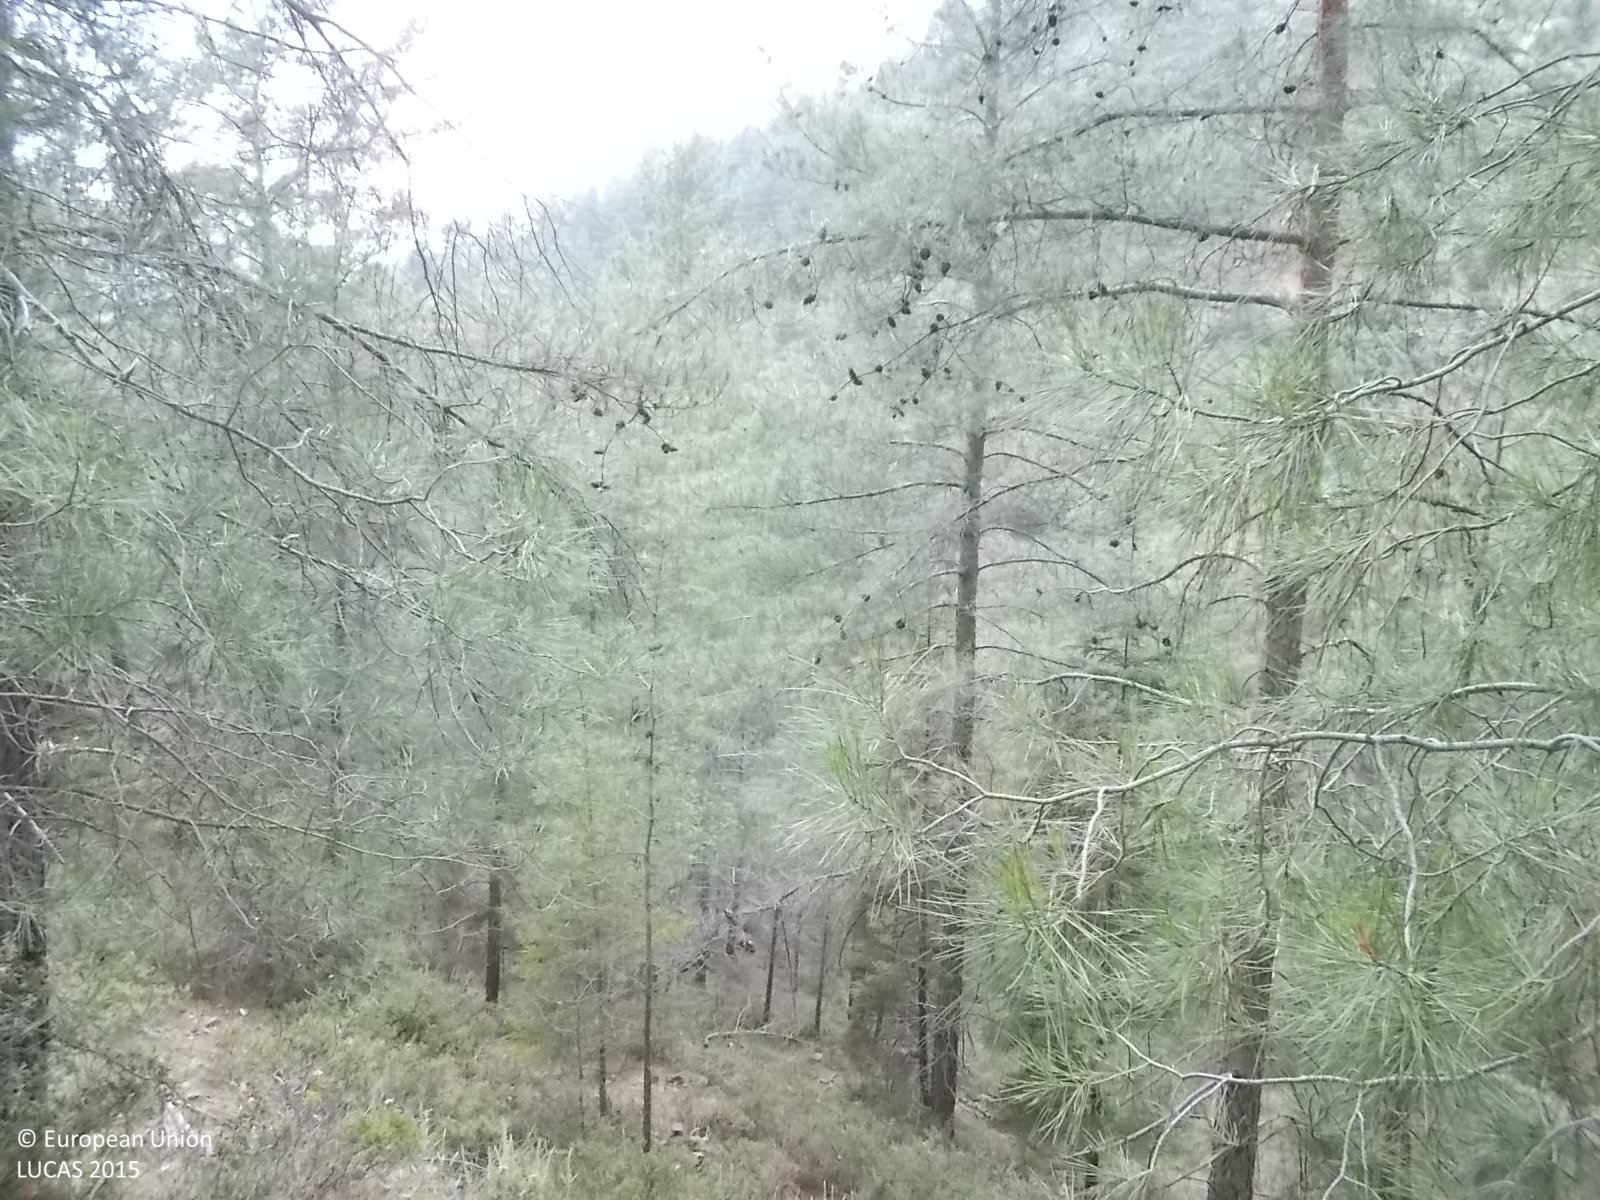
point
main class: Woodland
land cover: Pine dominated coniferous woodland
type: coniferous forest of the mediterranean region
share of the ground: > 75 %
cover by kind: coniferous forest trees 95 %, shrubs 5 %
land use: Forestry
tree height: > 5 m
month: June
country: CY
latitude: 35.0397
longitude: 32.6220
